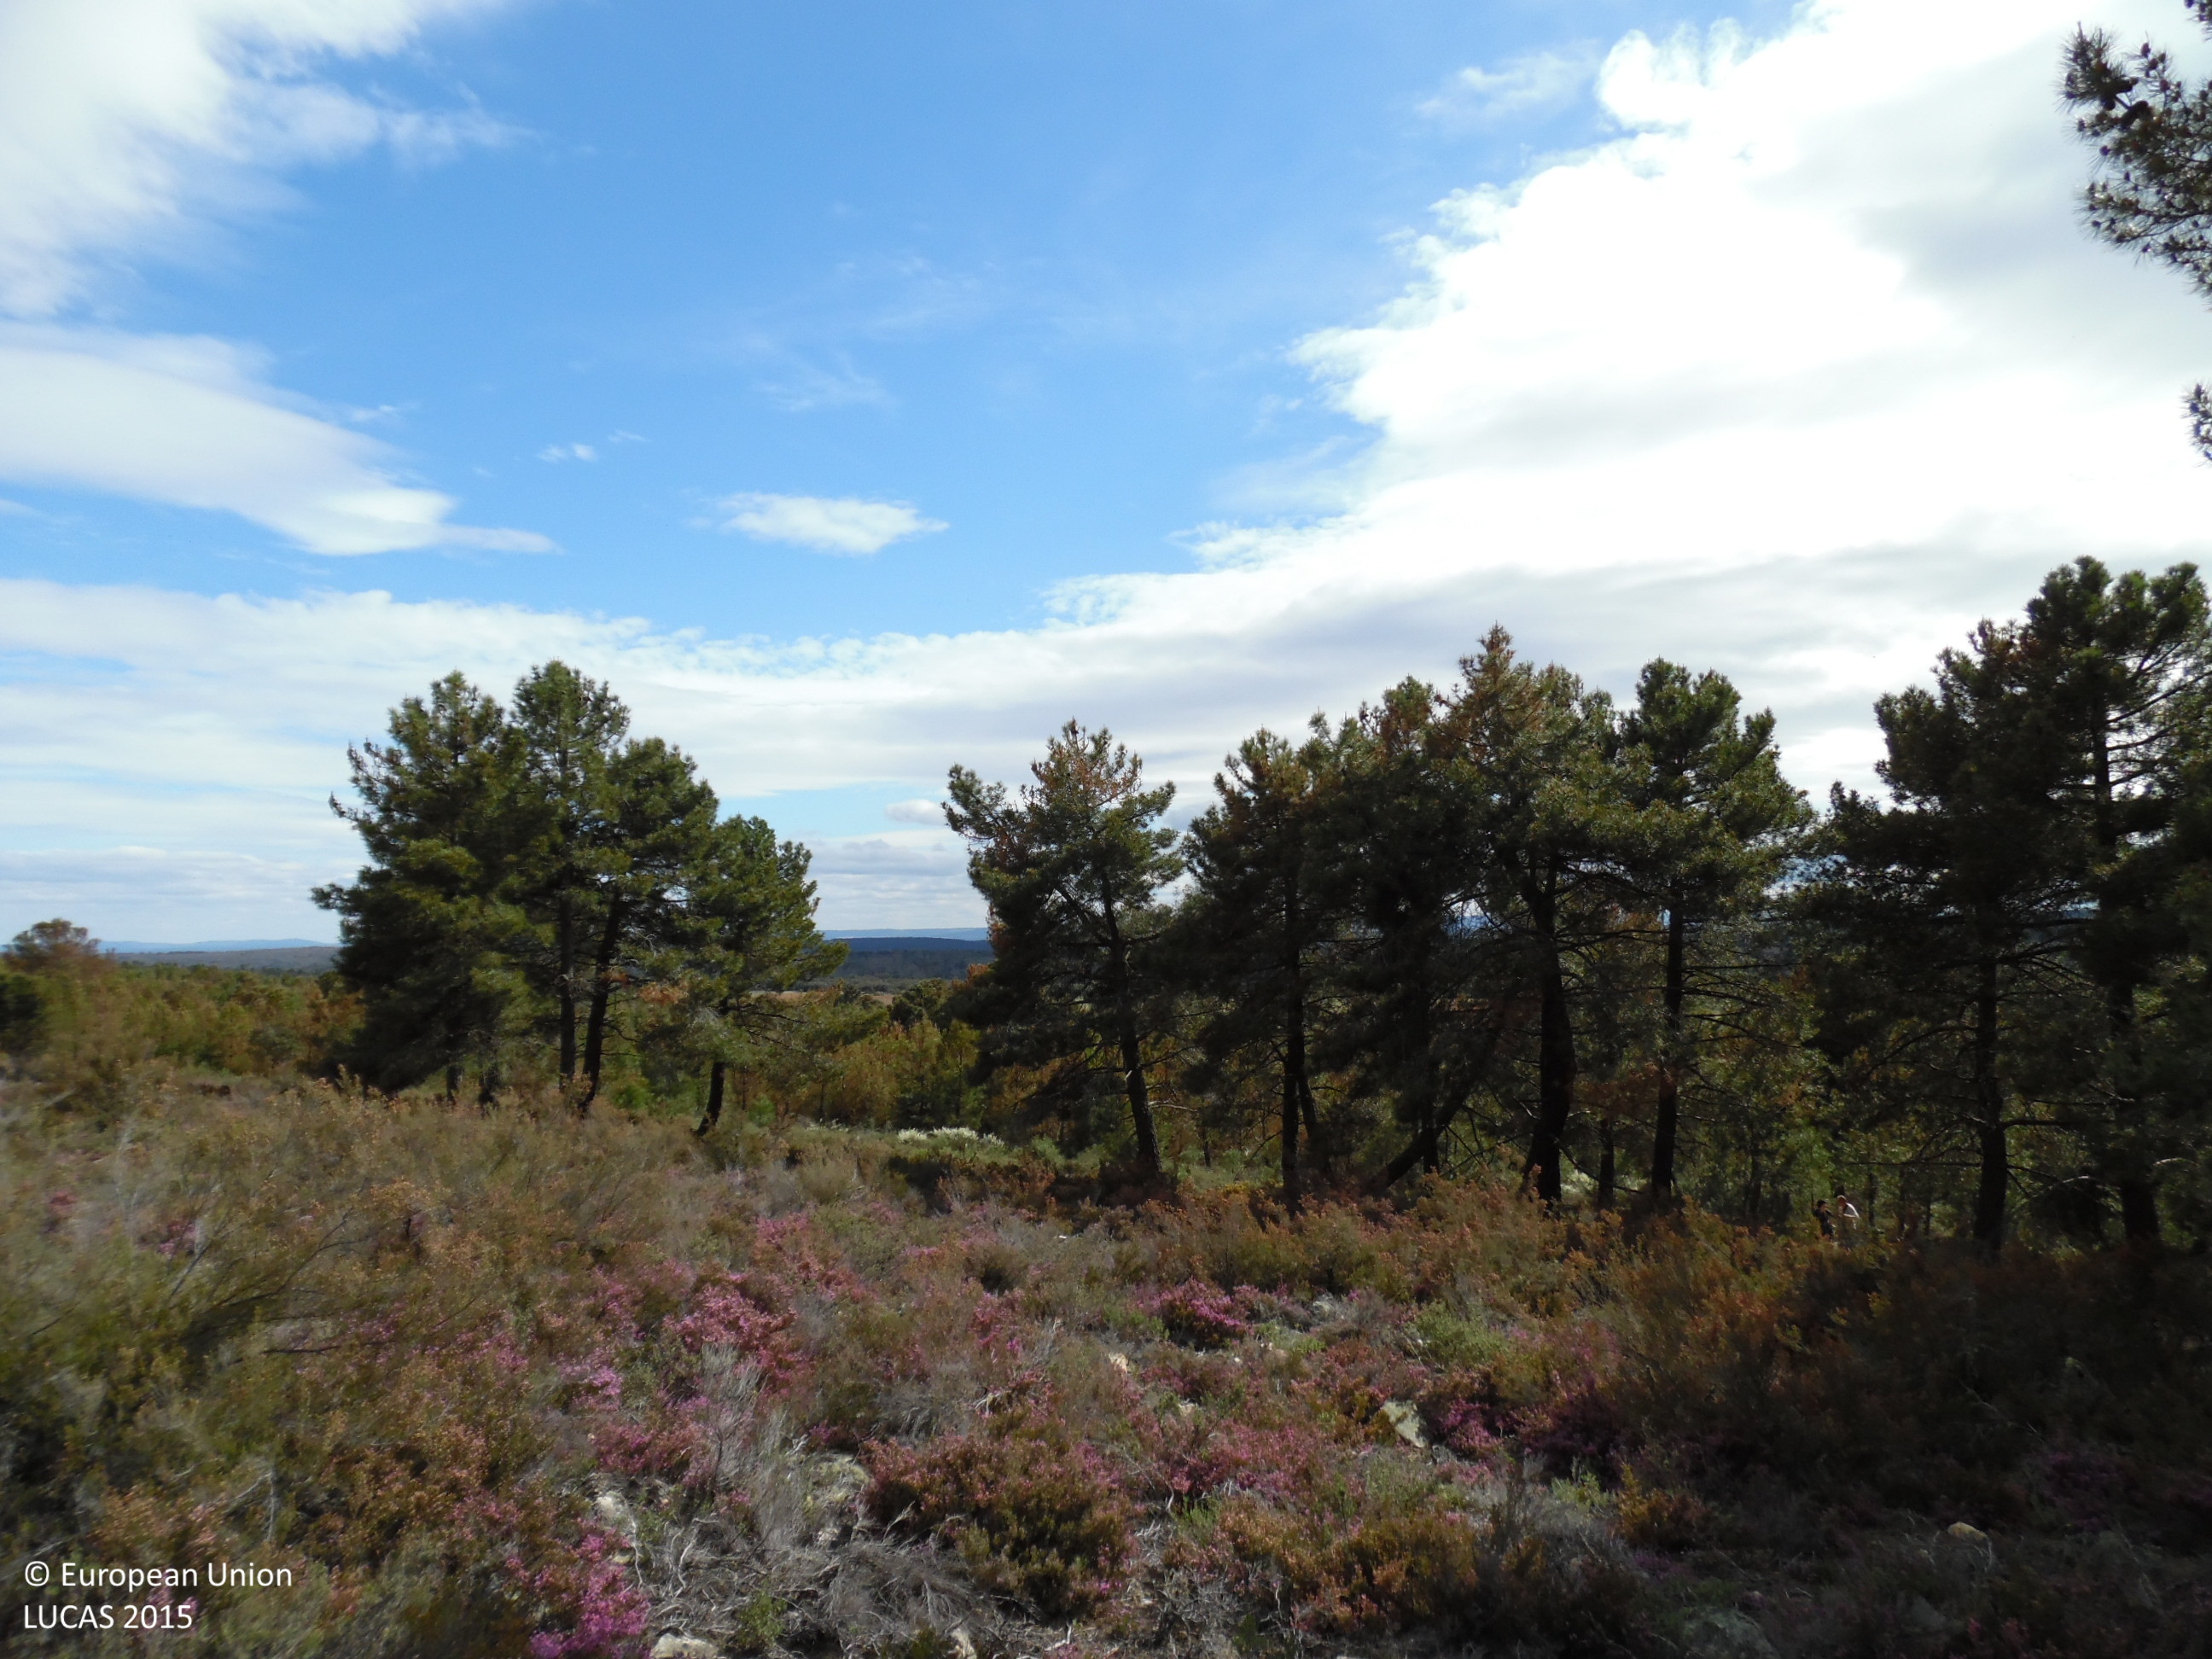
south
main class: Shrubland
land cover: Shrubland with sparse tree cover
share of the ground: > 75 %
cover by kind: shrubs 95 %, coniferous forest trees 5 %
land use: Forestry
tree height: > 5 m
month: April
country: ES
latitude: 42.1737
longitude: -6.0452
